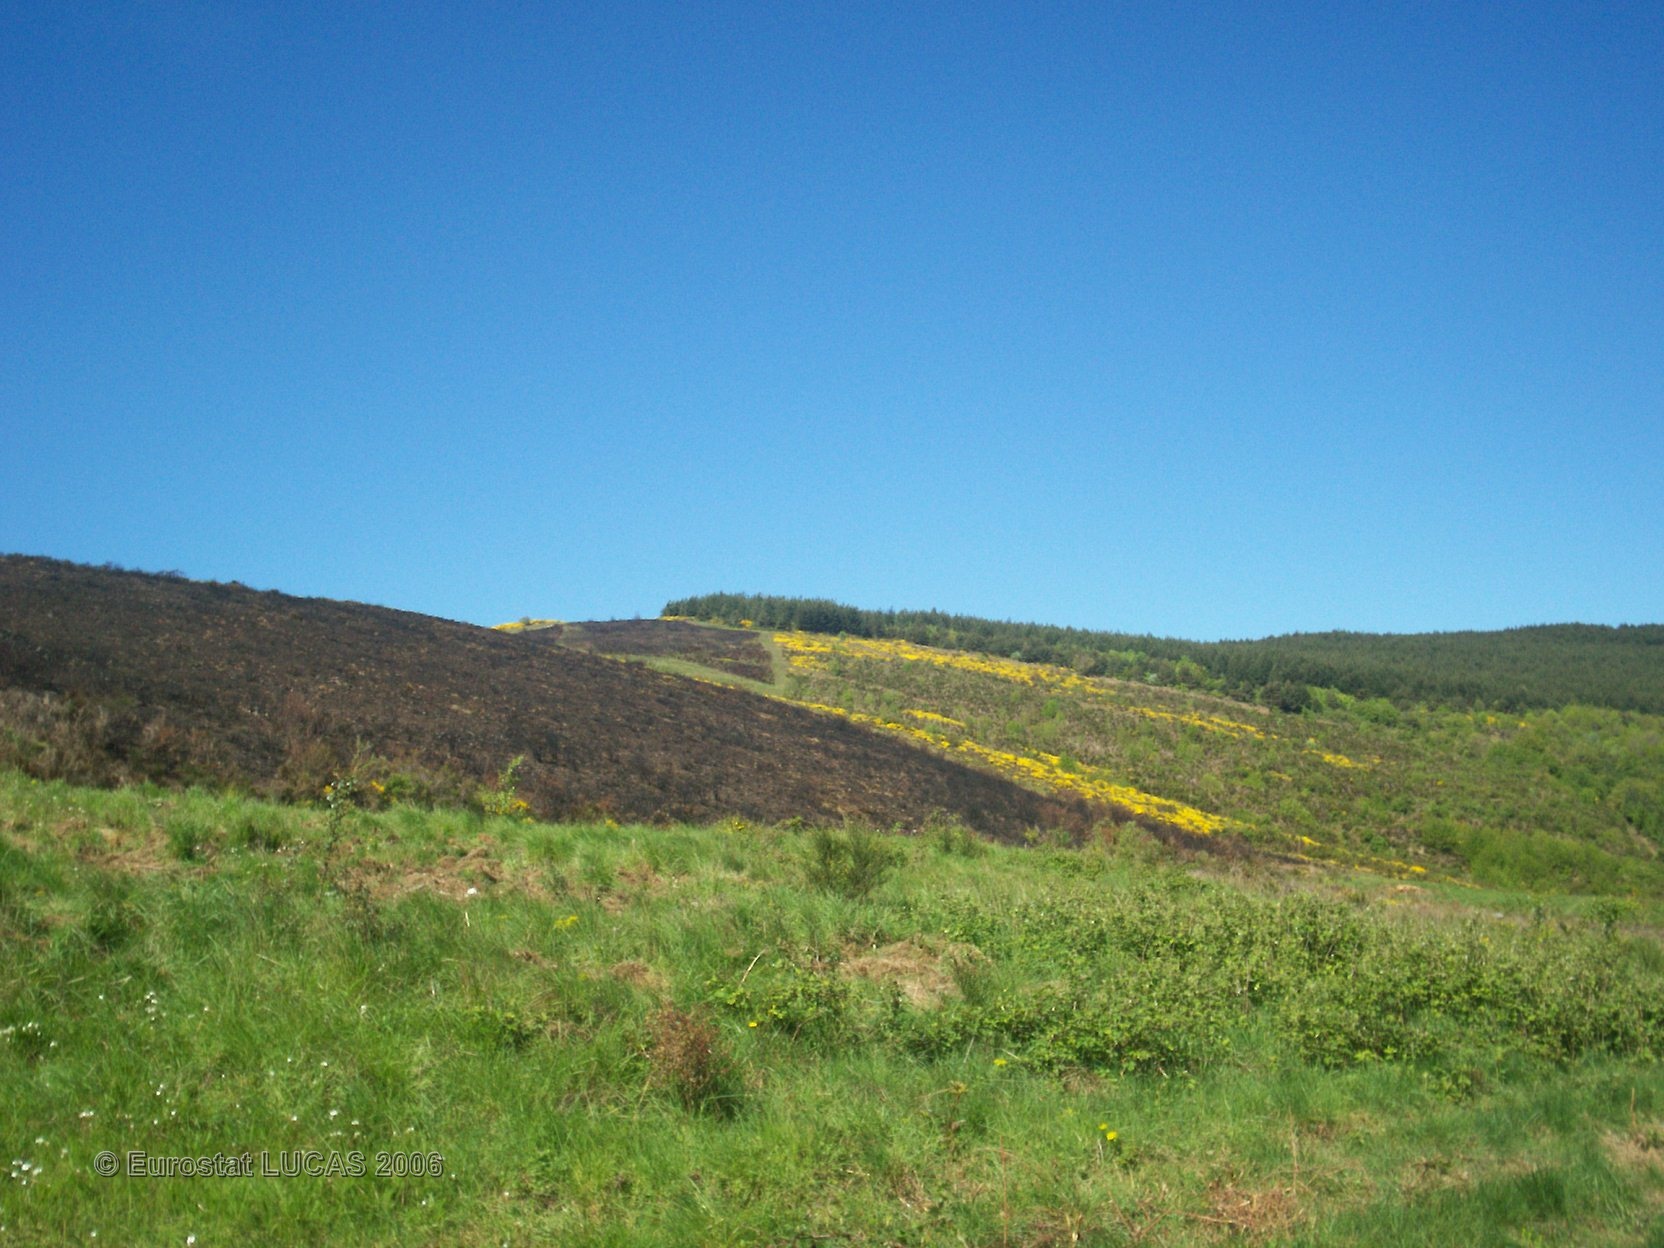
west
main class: Grassland
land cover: Grassland without tree/shrub cover
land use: Agriculture (excluding fallow land and kitchen gardens)
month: May
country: FR
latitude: 43.9799
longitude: 3.4372
